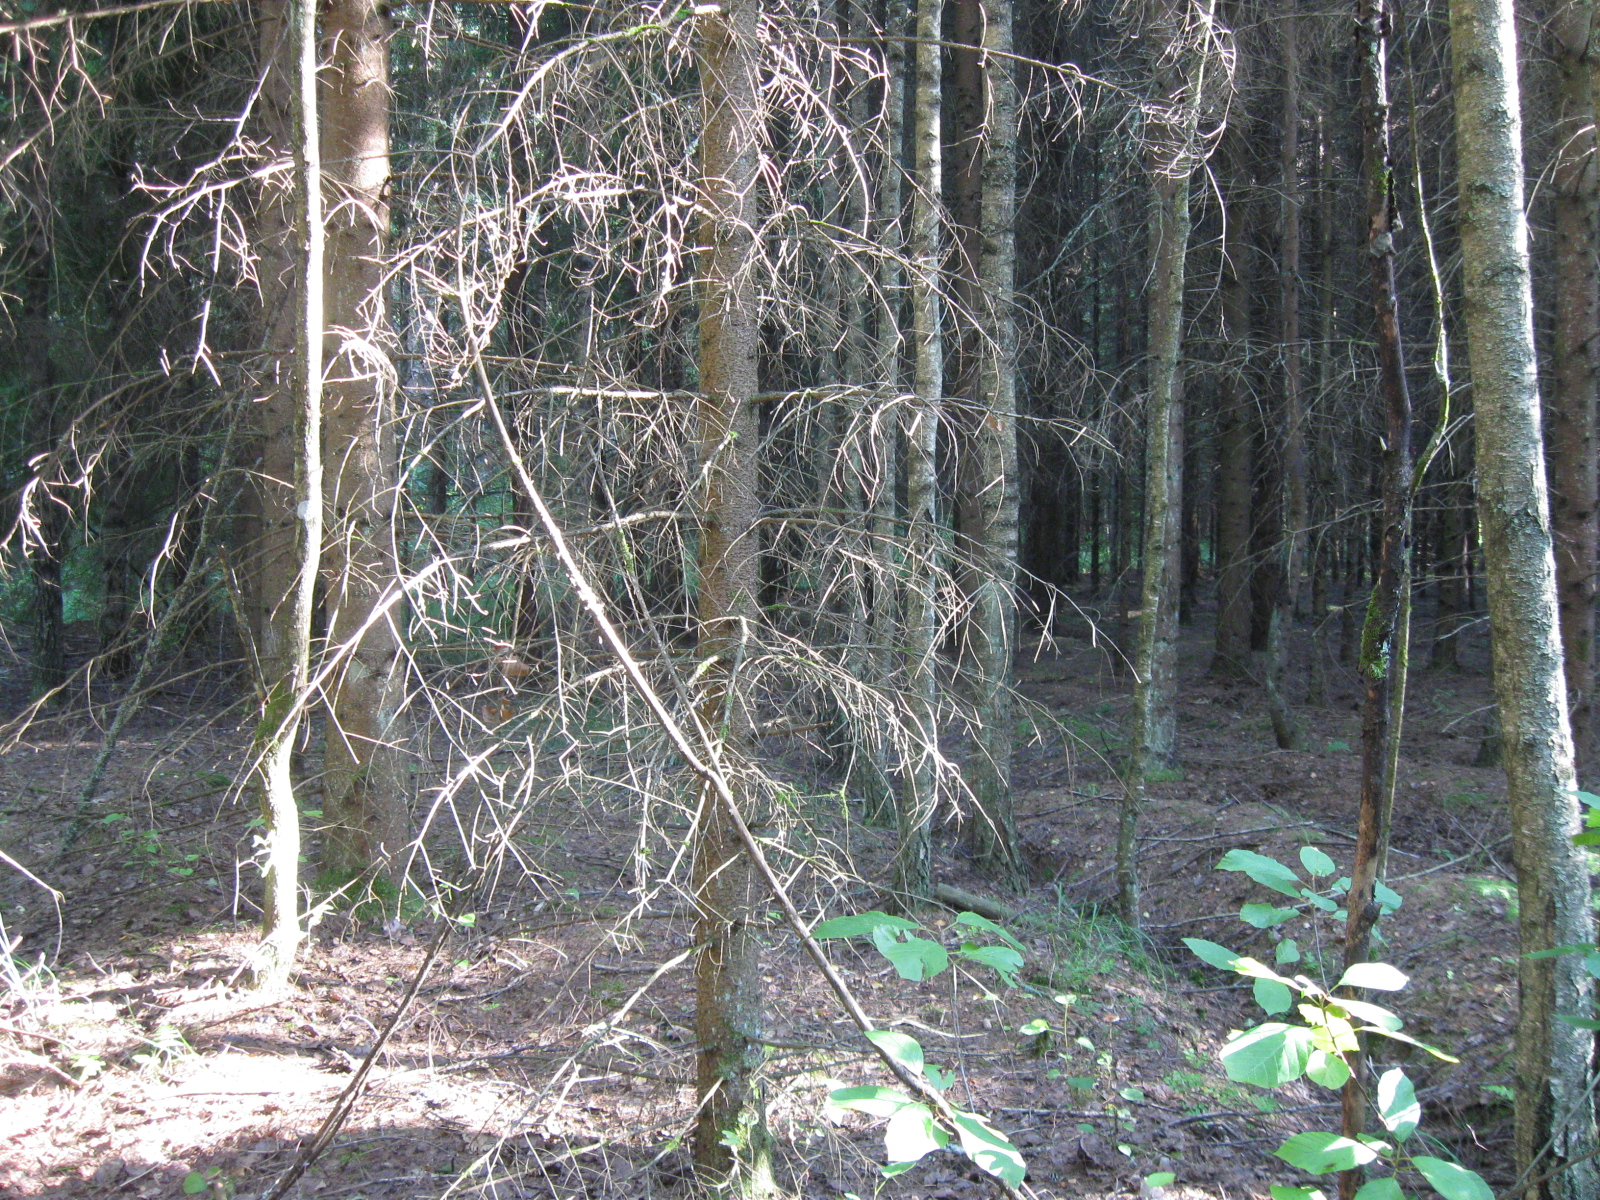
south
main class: Woodland
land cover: Spruce dominated mixed woodland
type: hemiboreal forest and nemoral coniferous forest and mixed broadleaved-coniferous forest
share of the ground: > 75 %
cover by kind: coniferous forest trees 55 %, broadleaved forest trees 30 %, herbaceous plants 10 %, unconsolidated bare surface 5 %
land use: Forestry
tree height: > 5 m
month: August
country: LT
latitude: 54.8712
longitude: 23.4662
